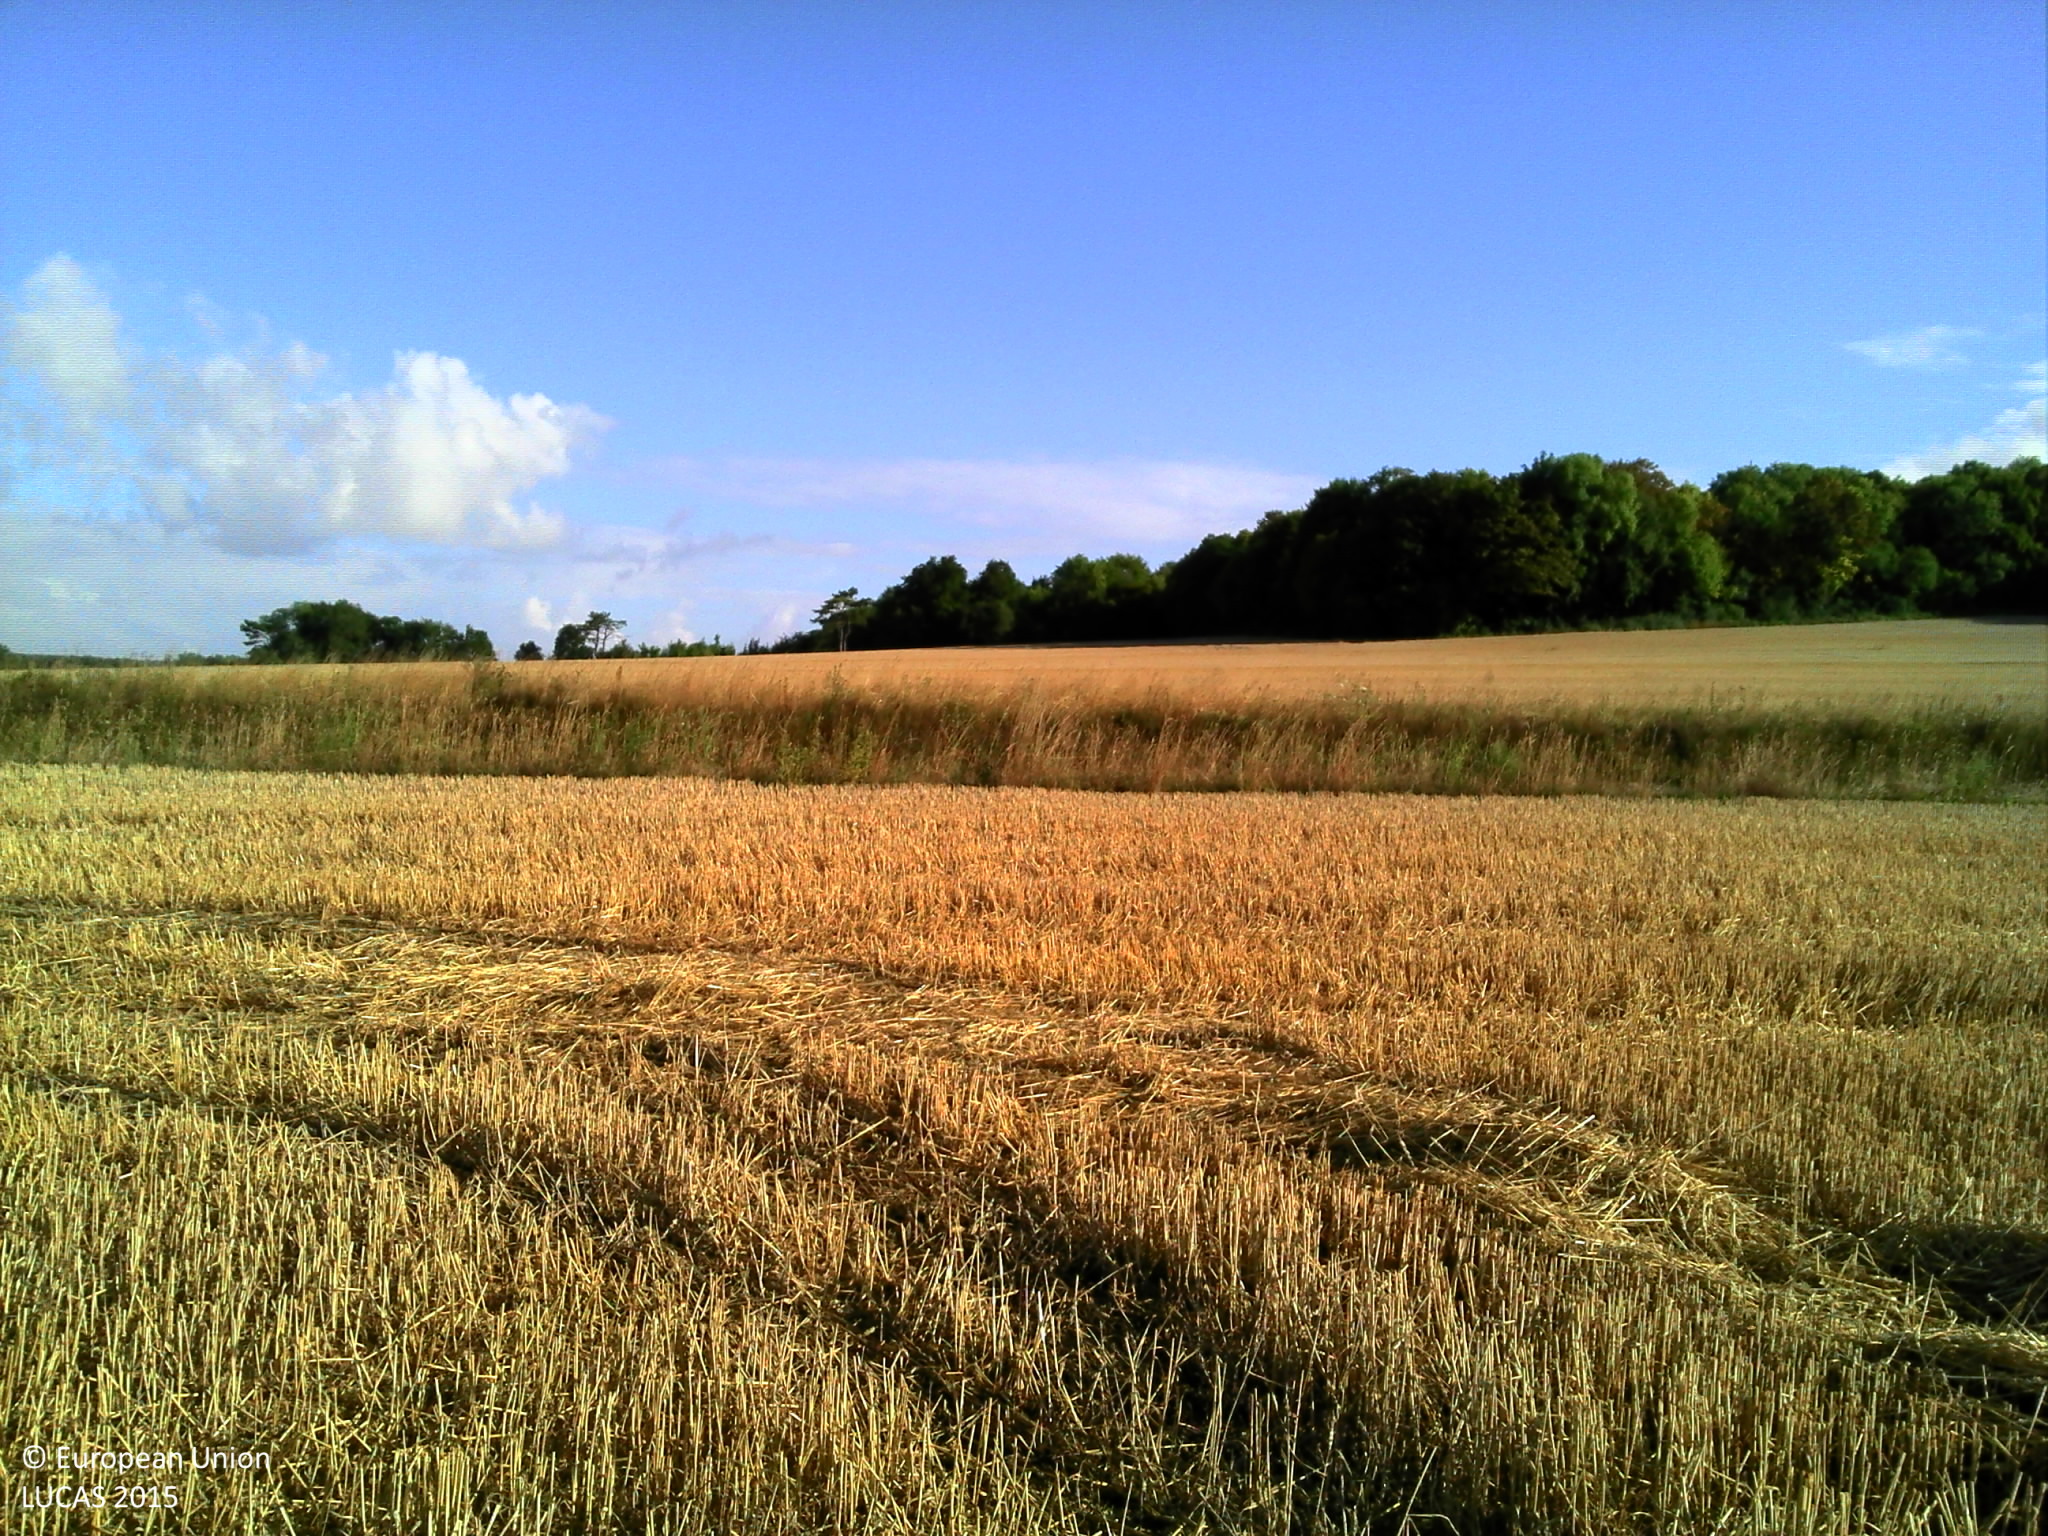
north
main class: Cropland
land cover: Common wheat
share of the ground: > 75 %
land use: Agriculture (excluding fallow land and kitchen gardens)
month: July
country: FR
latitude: 49.9516
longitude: 2.4474
